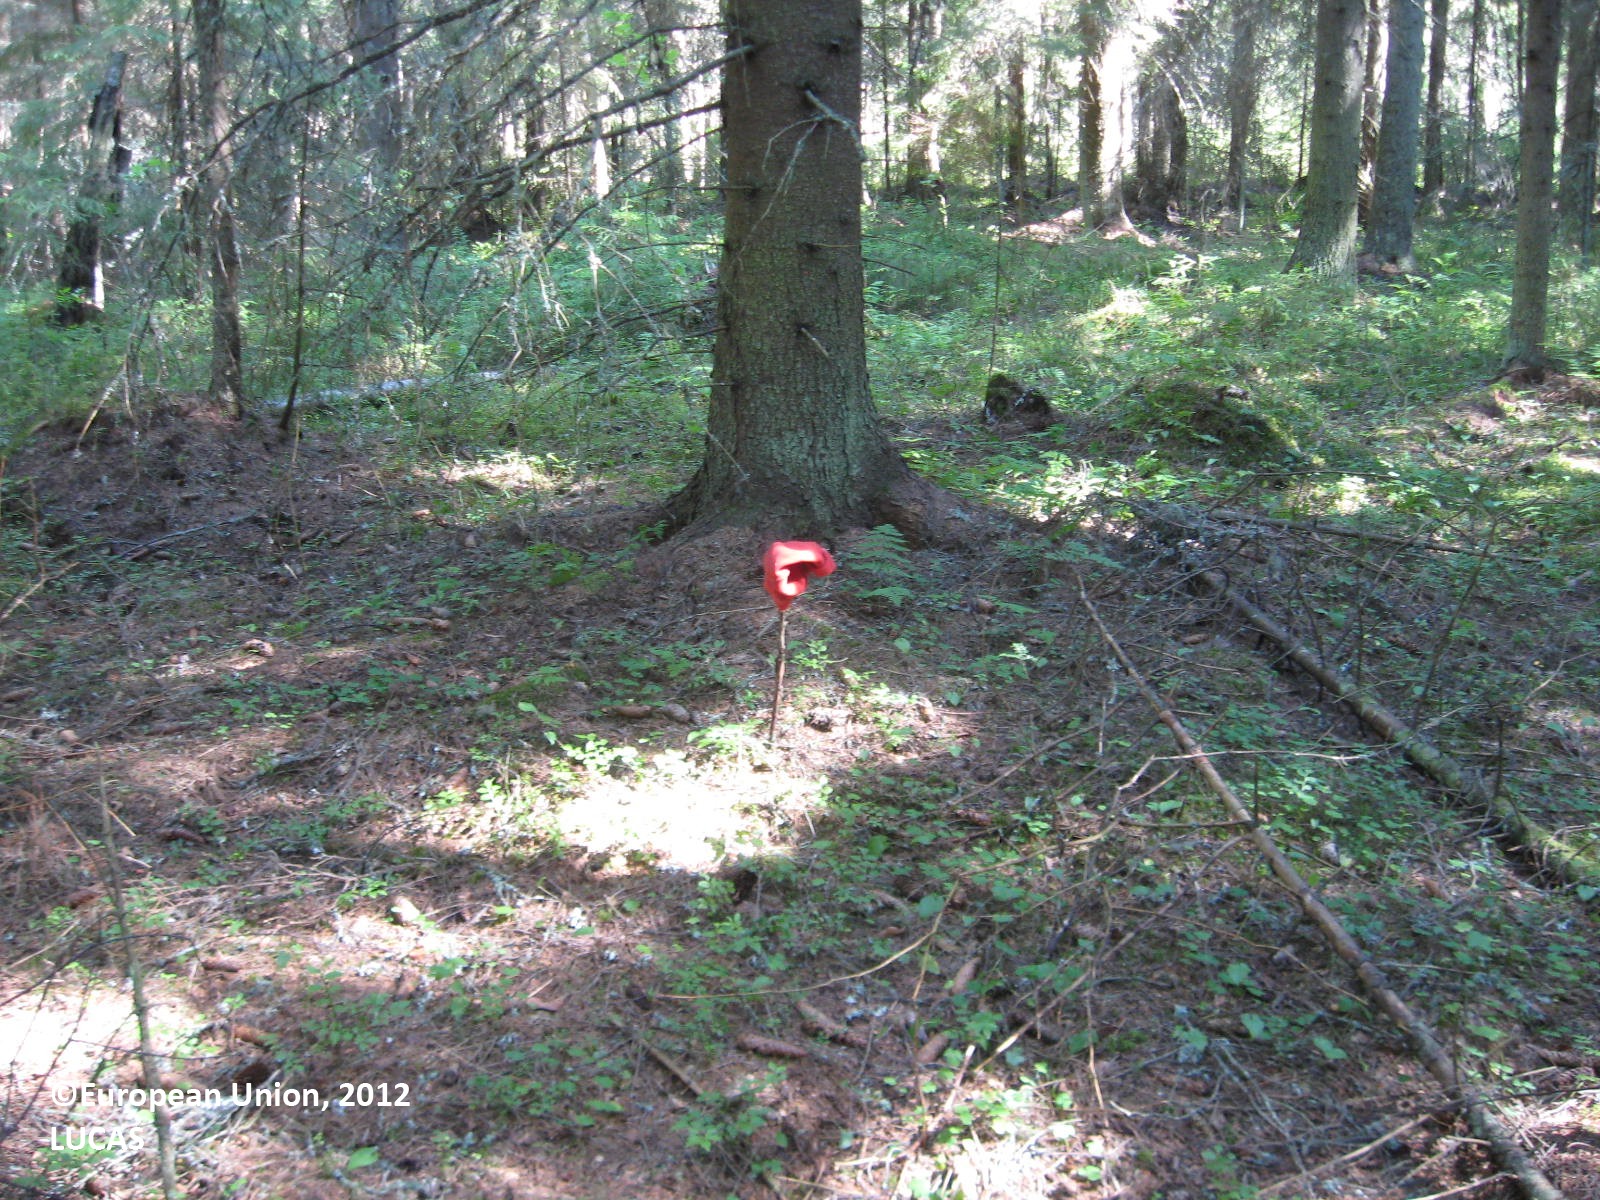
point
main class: Woodland
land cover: Spruce dominated coniferous woodland
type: boreal forest
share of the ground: > 75 %
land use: Forestry
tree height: > 5 m
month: July
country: FI
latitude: 62.1933
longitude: 21.6730
